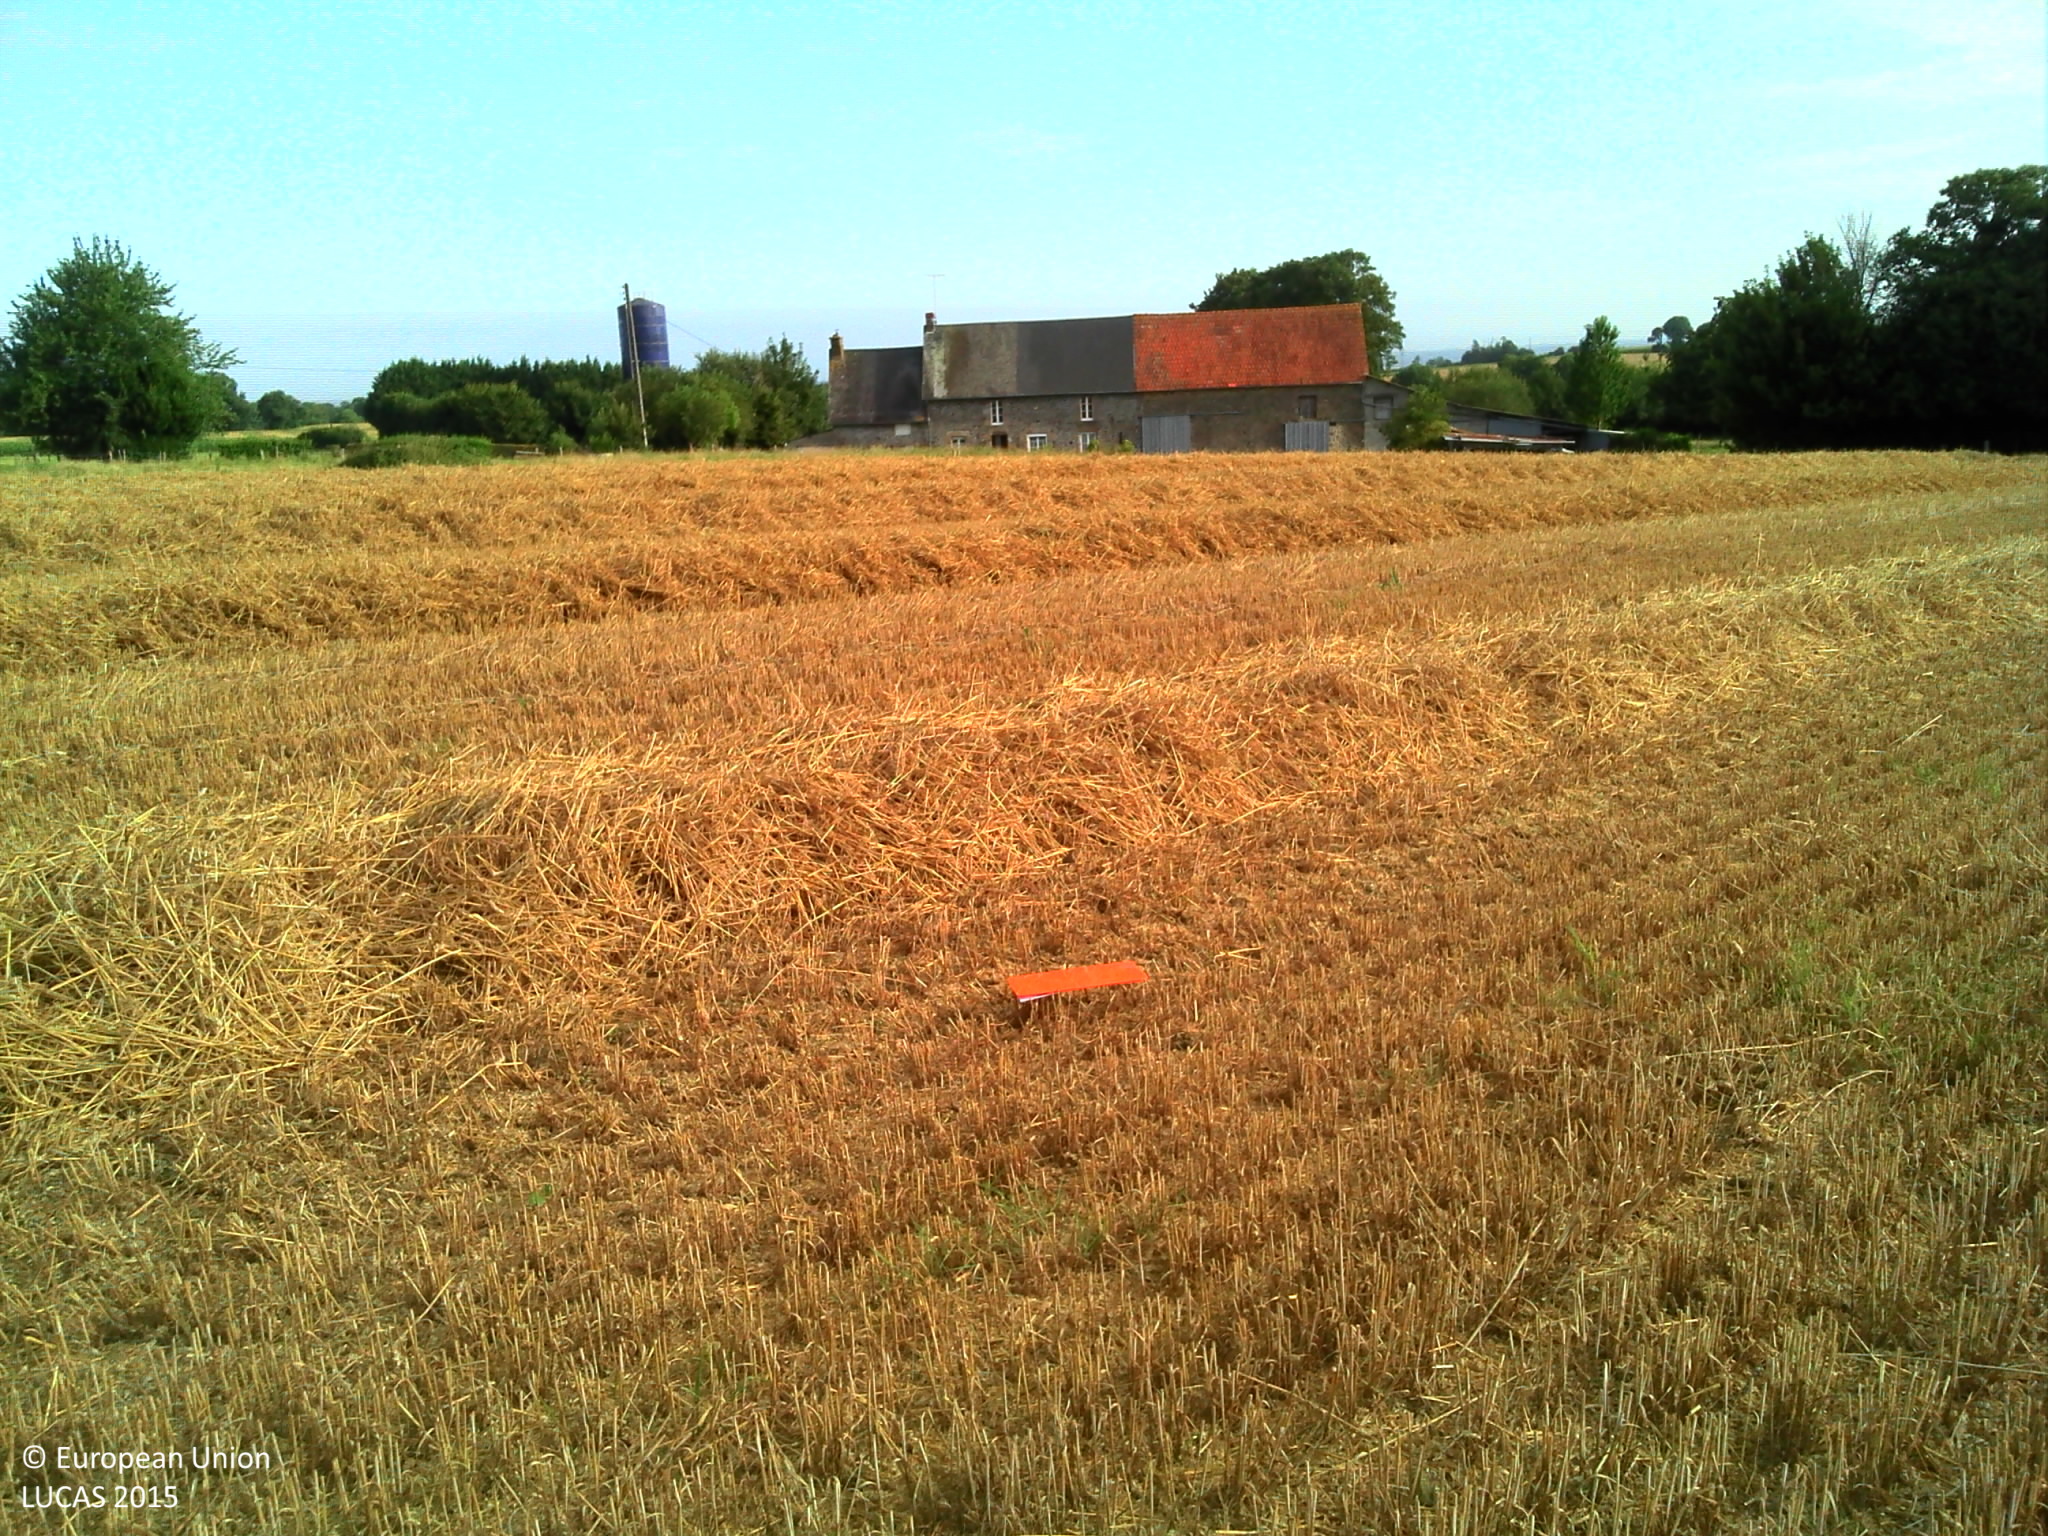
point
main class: Cropland
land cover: Common wheat
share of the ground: > 75 %
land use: Agriculture (excluding fallow land and kitchen gardens)
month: August
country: FR
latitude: 48.5309
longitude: -1.2978
